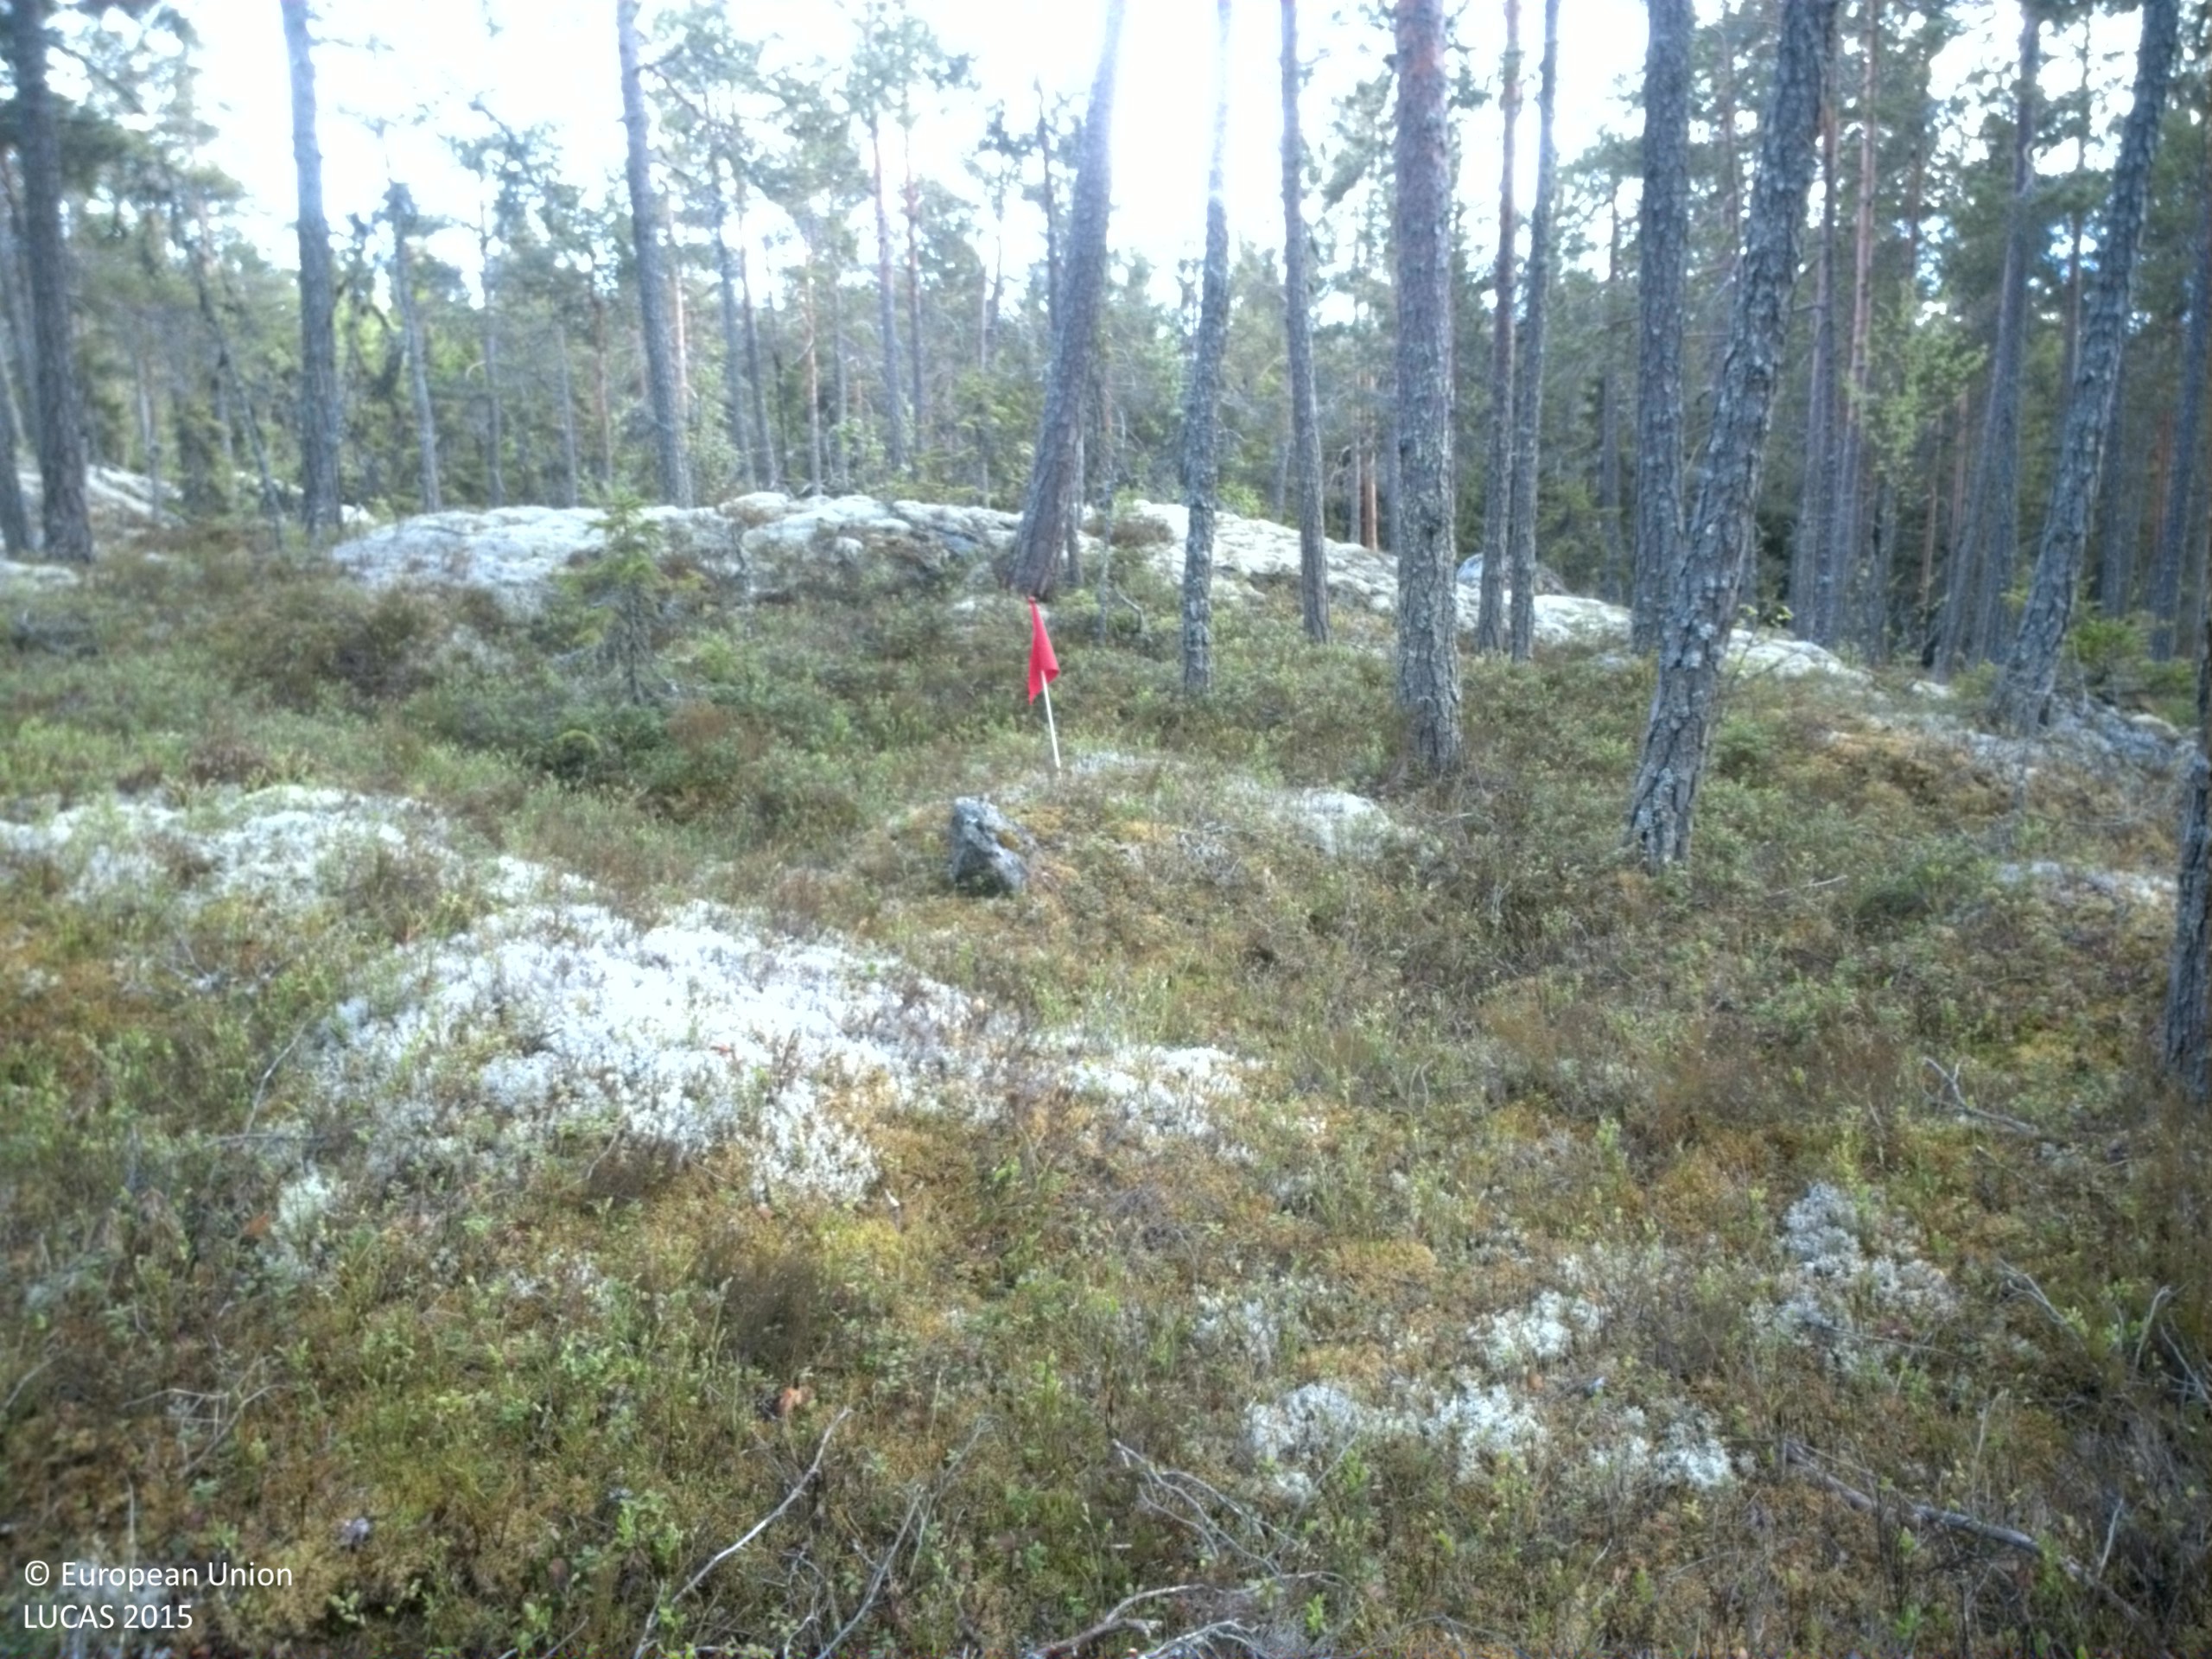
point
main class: Woodland
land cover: Pine dominated coniferous woodland
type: boreal forest
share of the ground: 25 - 50 %
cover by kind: coniferous forest trees 35 %, shrubs 30 %, lichens and mosses 30 %, consolidated bare surface 5 %
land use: Forestry
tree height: > 5 m
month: May
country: SE
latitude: 63.1170
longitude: 17.8070
